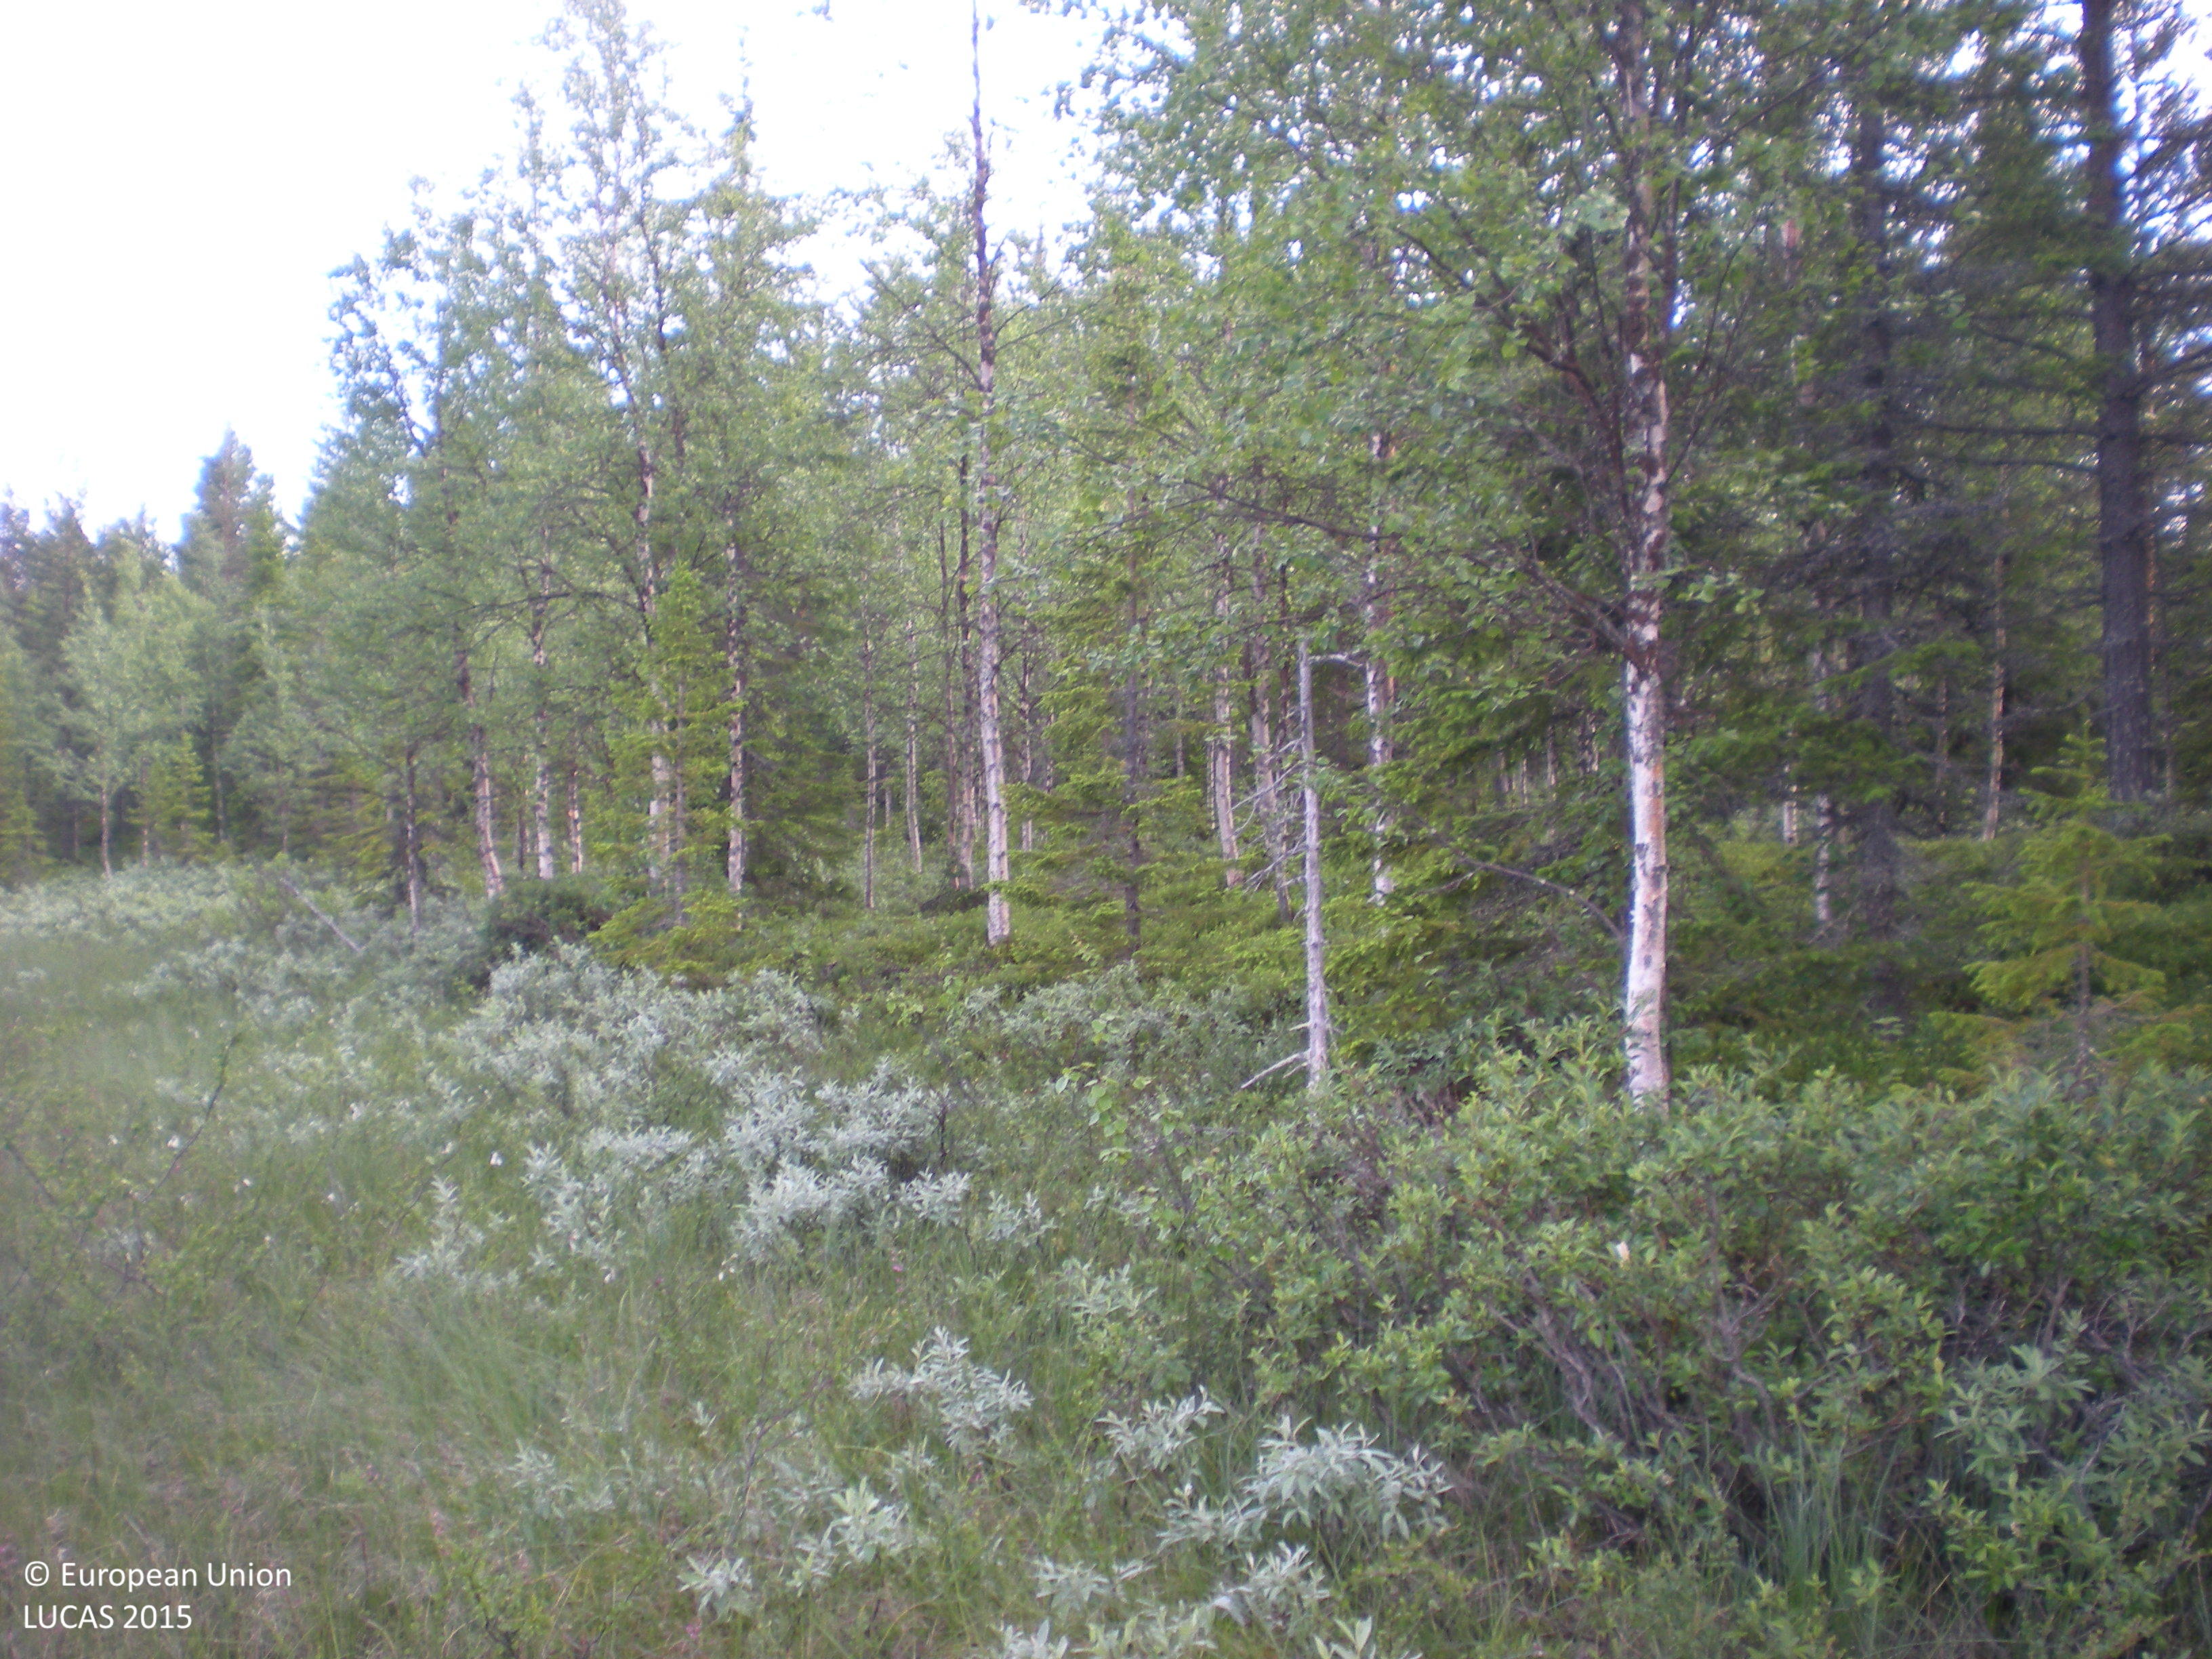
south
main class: Woodland
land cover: Spruce dominated mixed woodland
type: boreal forest
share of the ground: 50 - 75 %
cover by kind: coniferous forest trees 35 %, shrubs 30 %, broadleaved forest trees 25 %, lichens and mosses 10 %
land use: Forestry
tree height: > 5 m
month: July
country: SE
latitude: 65.6994
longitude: 17.7326
